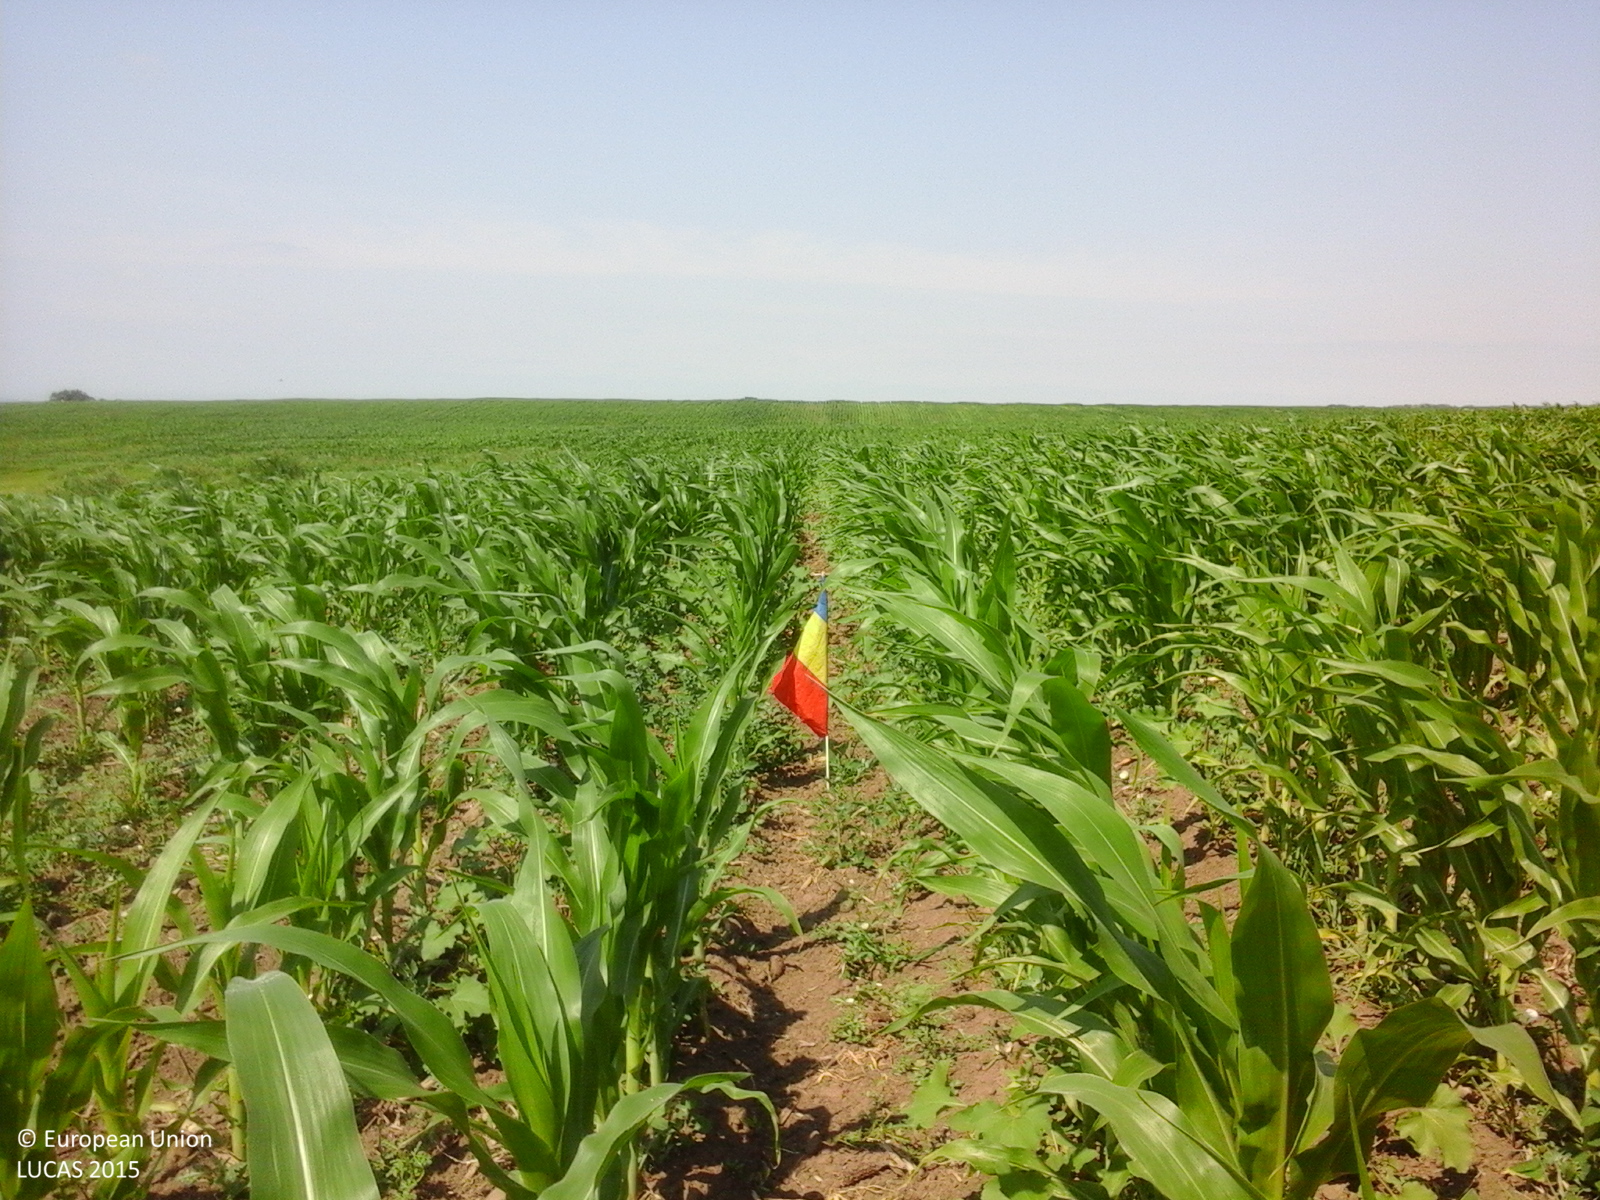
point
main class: Cropland
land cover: Maize
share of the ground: 50 - 75 %
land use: Agriculture (excluding fallow land and kitchen gardens)
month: June
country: RO
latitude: 46.7787
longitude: 27.0067
